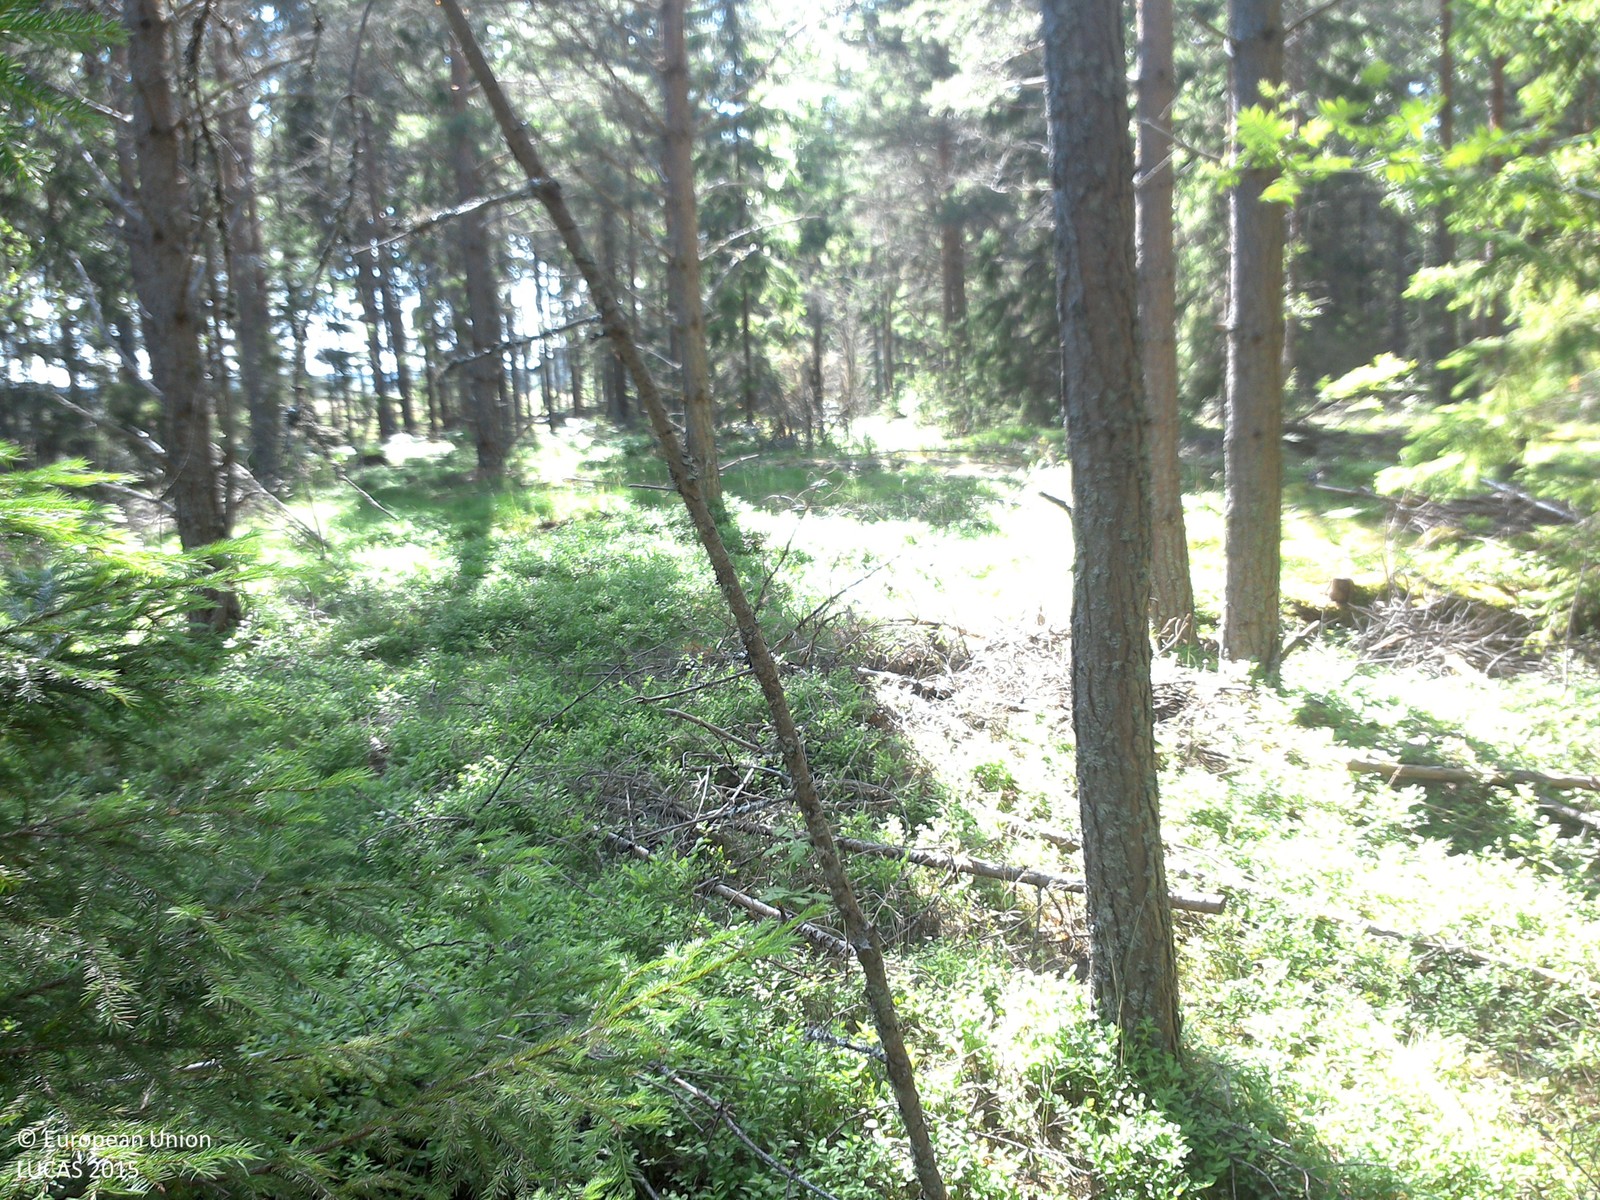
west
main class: Woodland
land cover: Pine dominated coniferous woodland
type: boreal forest
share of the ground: 50 - 75 %
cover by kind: coniferous forest trees 65 %, lichens and mosses 20 %, herbaceous plants 10 %, broadleaved forest trees 5 %
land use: Forestry
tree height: > 5 m
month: June
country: SE
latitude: 58.2499
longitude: 15.5323
